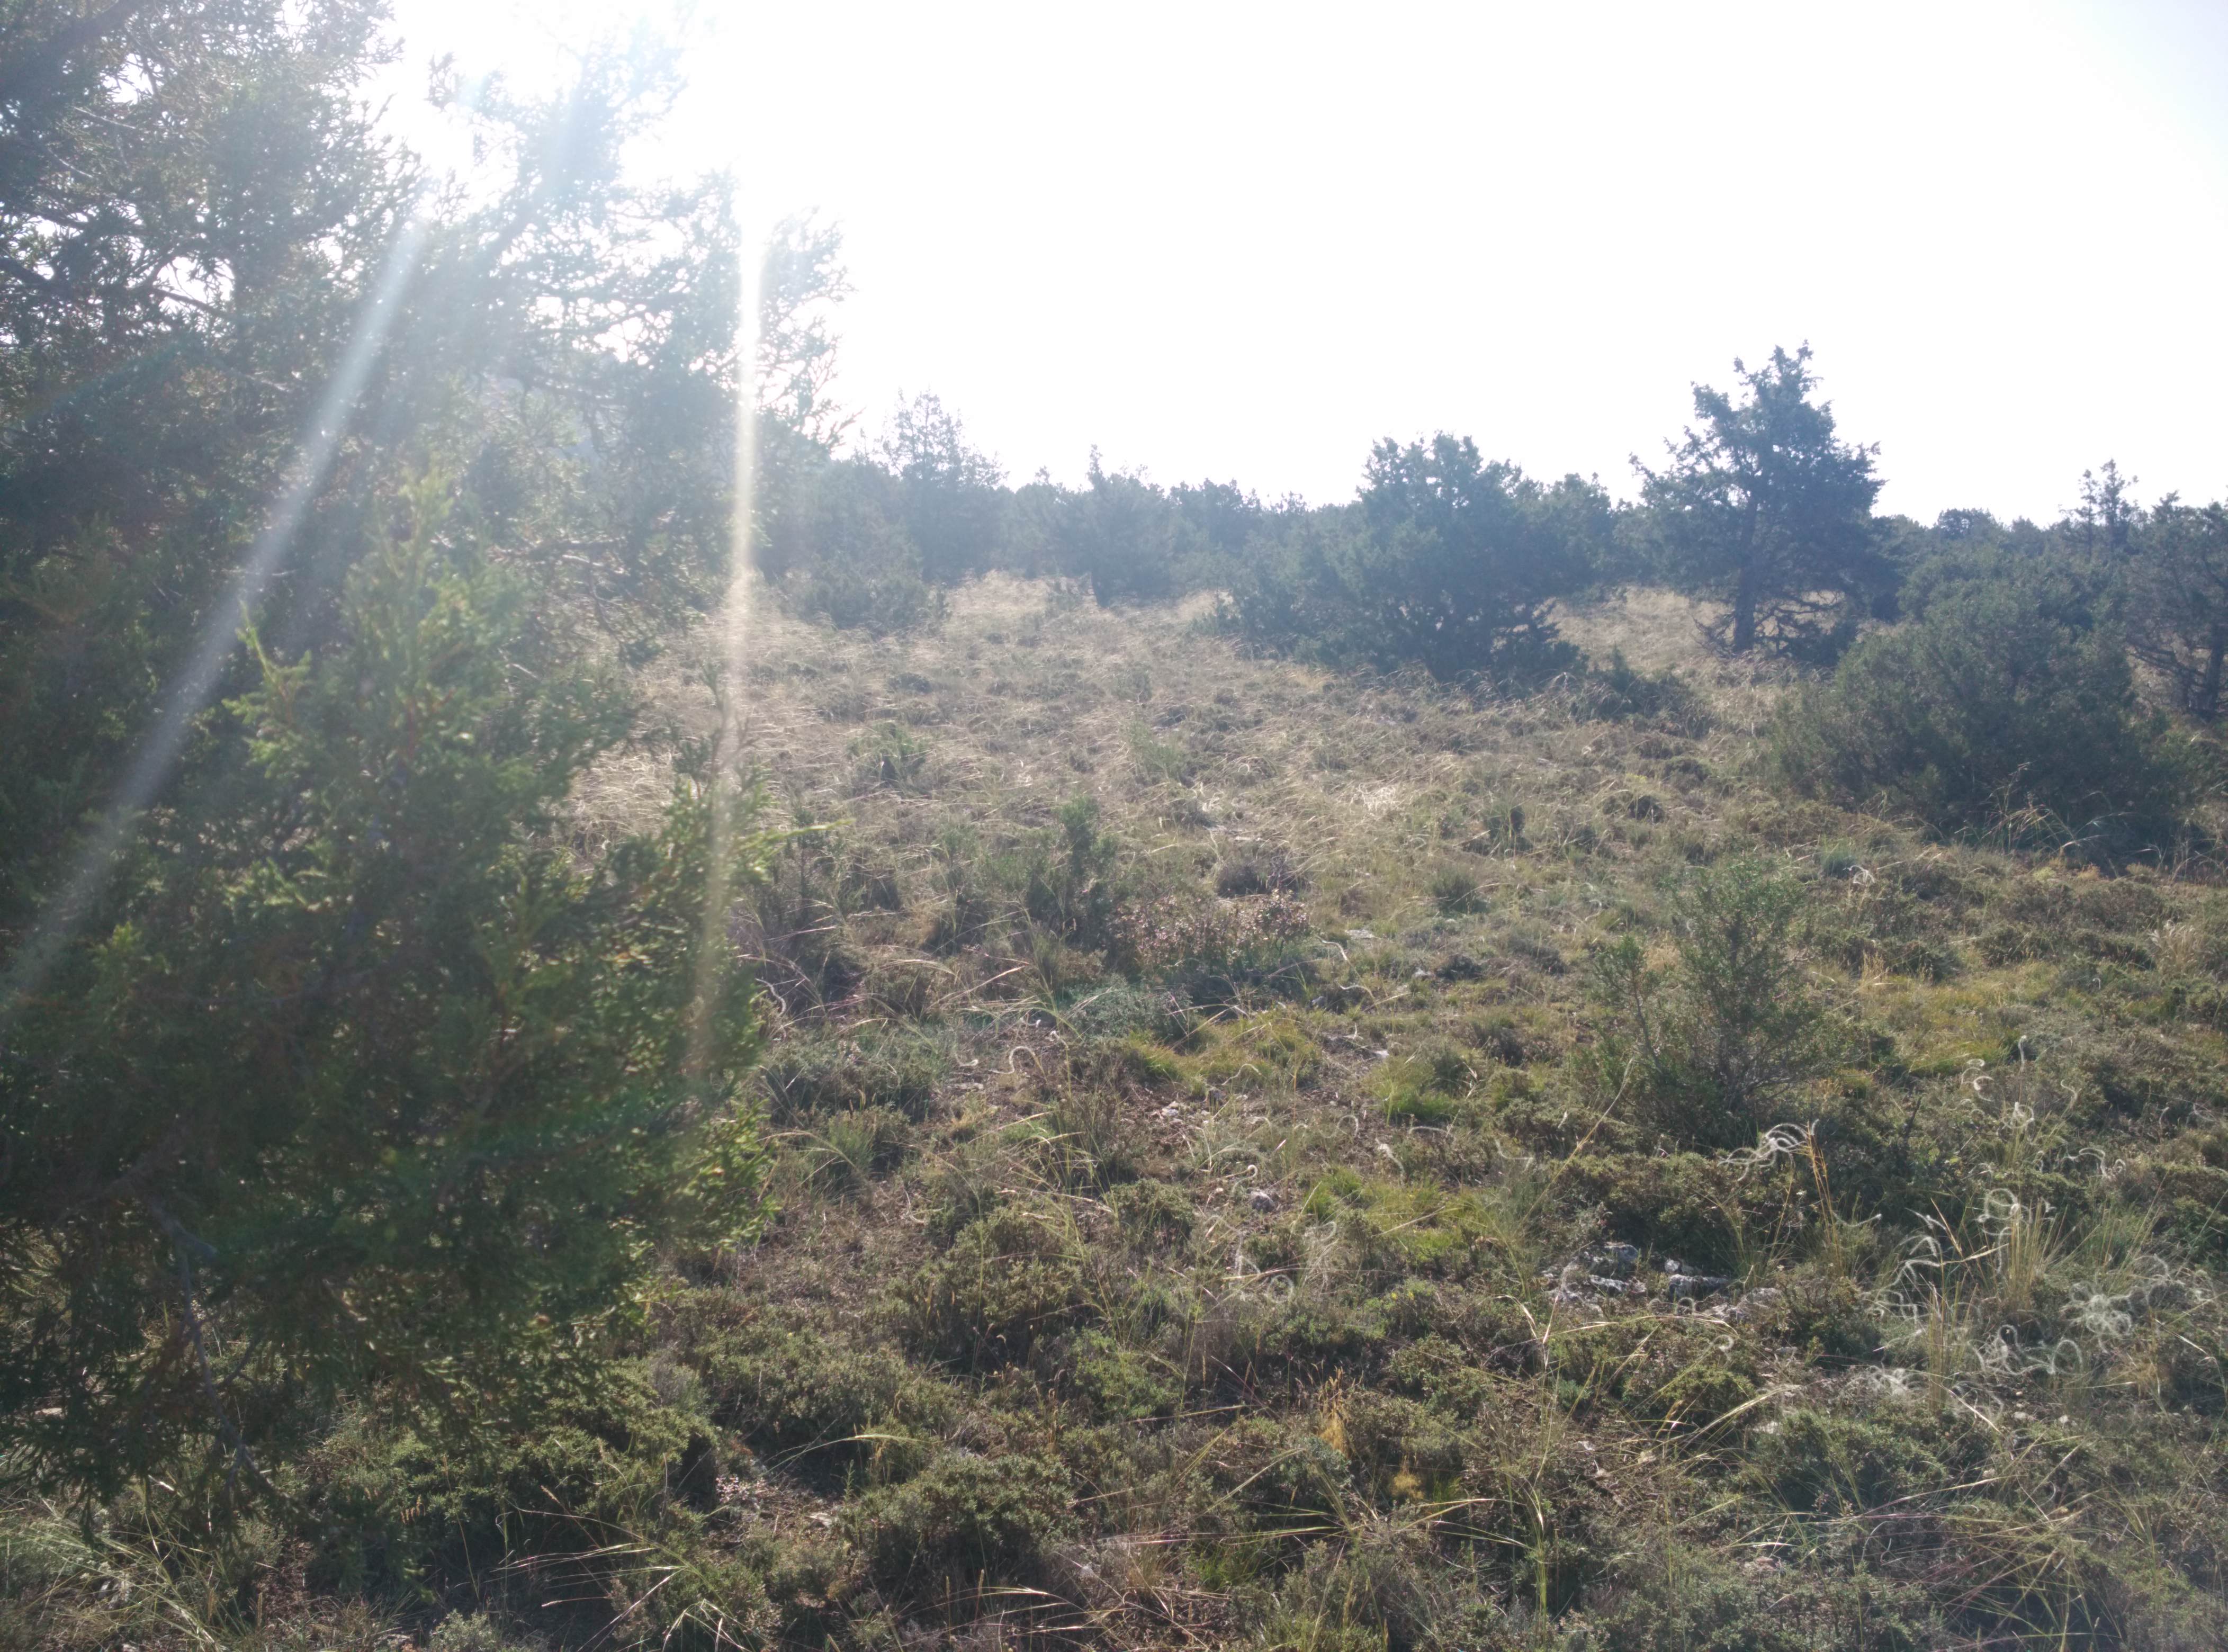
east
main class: Shrubland
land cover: Shrubland with sparse tree cover
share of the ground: 50 - 75 %
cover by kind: shrubs 60 %, unconsolidated bare surface 30 %, coniferous forest trees 5 %, herbaceous plants 5 %
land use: Semi-natural and natural areas not in use
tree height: > 5 m
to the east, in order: Shrubland with sparse tree cover; Other coniferous woodland
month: July
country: ES
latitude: 41.0546
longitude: -1.9111
